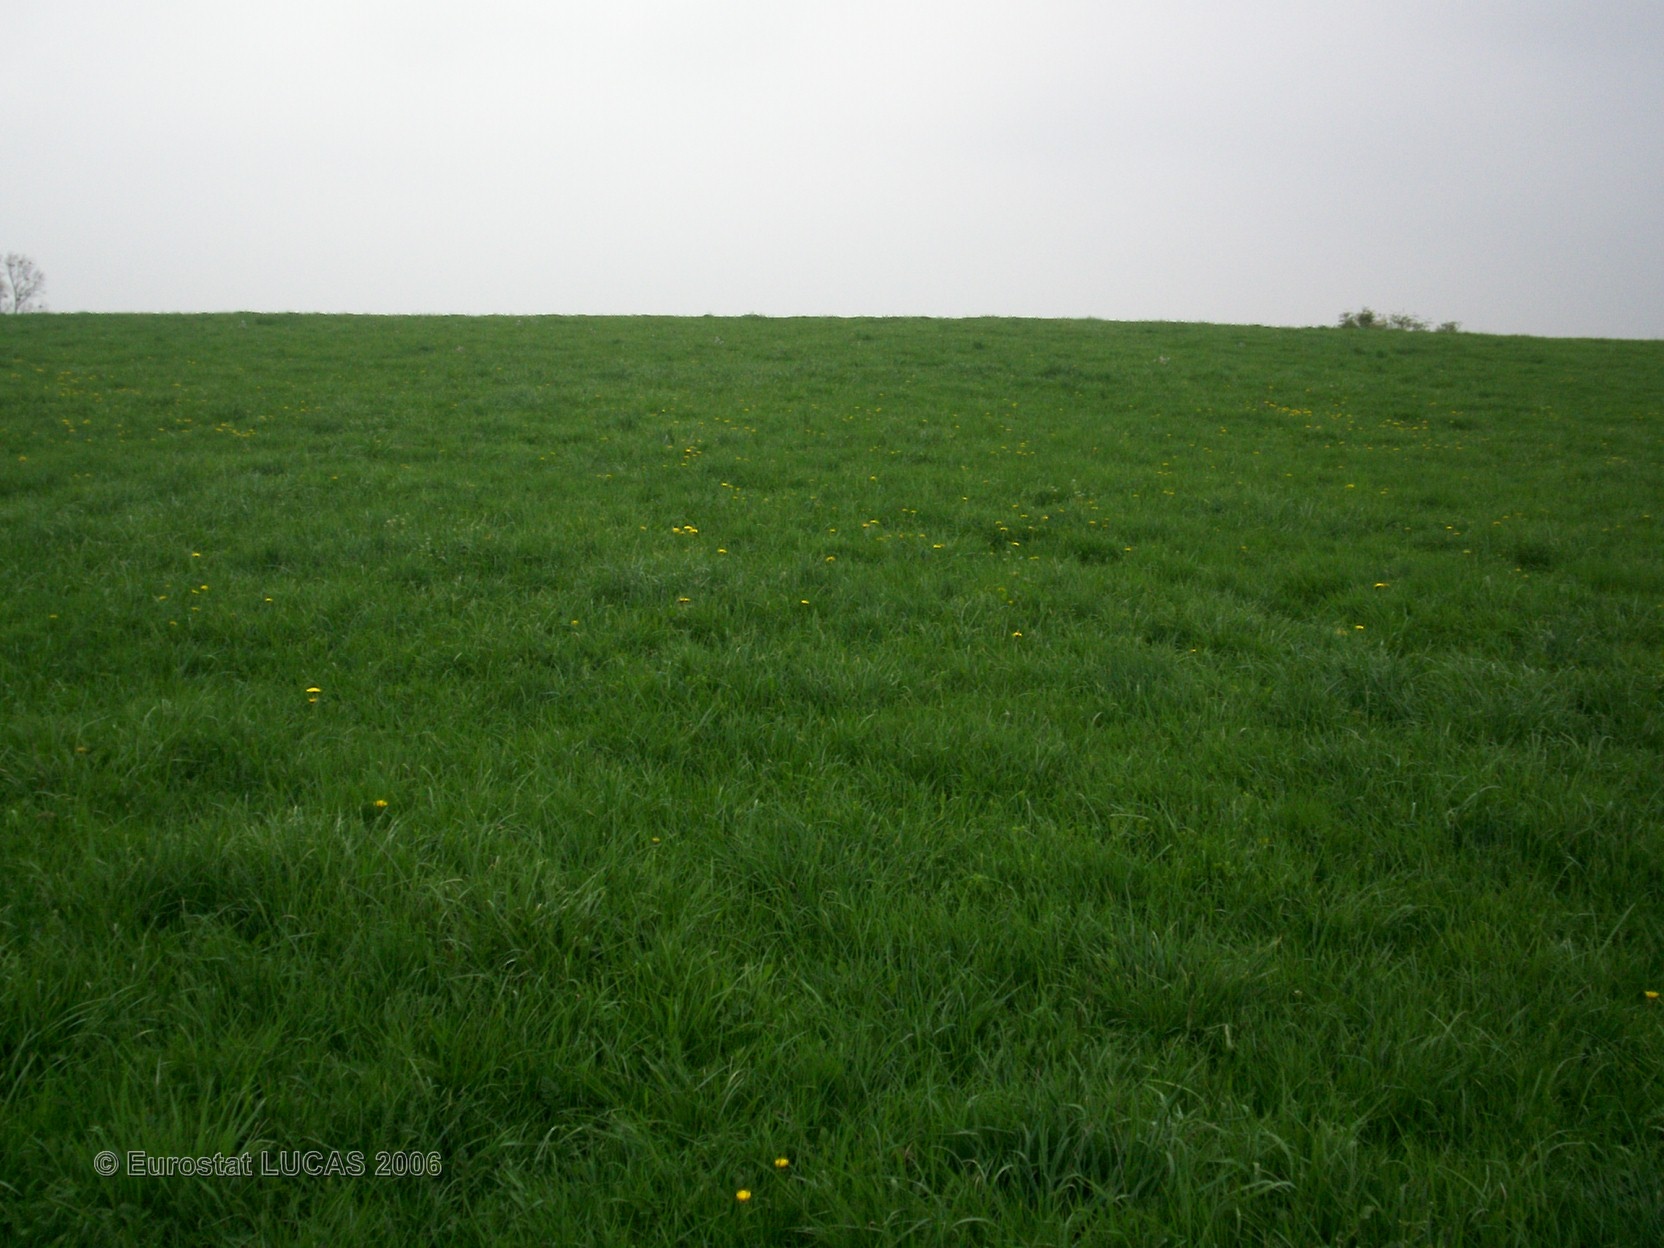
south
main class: Grassland
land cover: Grassland without tree/shrub cover
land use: Agriculture (excluding fallow land and kitchen gardens)
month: April
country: FR
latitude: 48.9152
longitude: 6.7936
